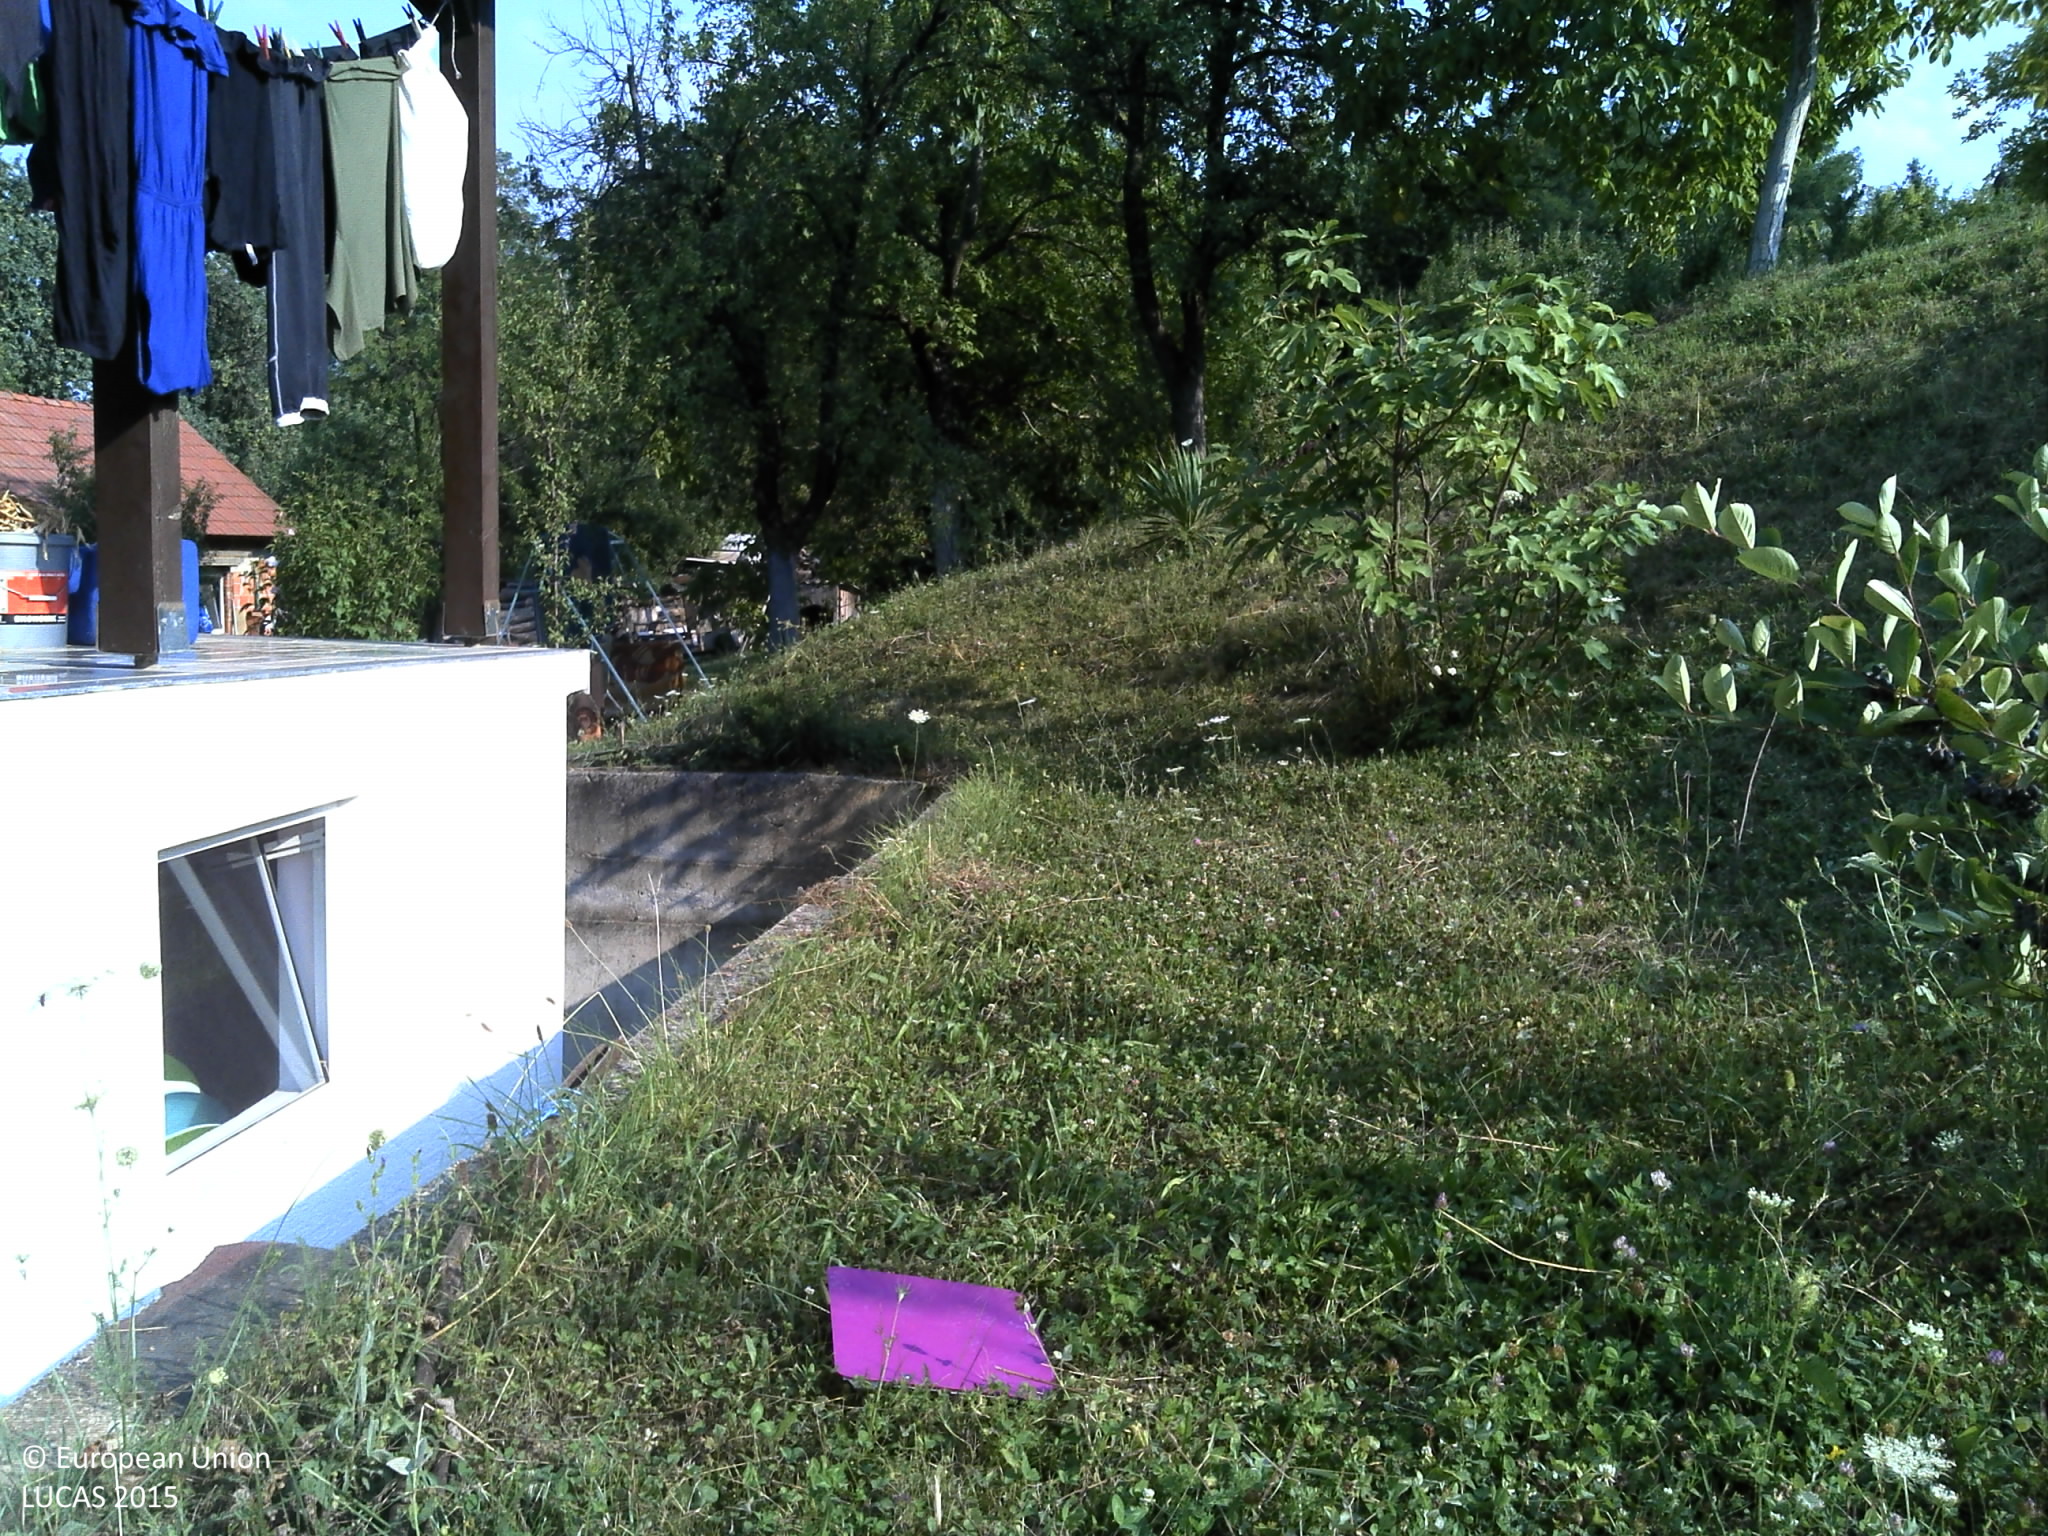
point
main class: Grassland
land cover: Spontaneously vegetated surfaces
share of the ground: > 75 %
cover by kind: herbaceous plants 100 %
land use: Fallow land
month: August
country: HR
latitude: 45.5846
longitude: 17.1909
